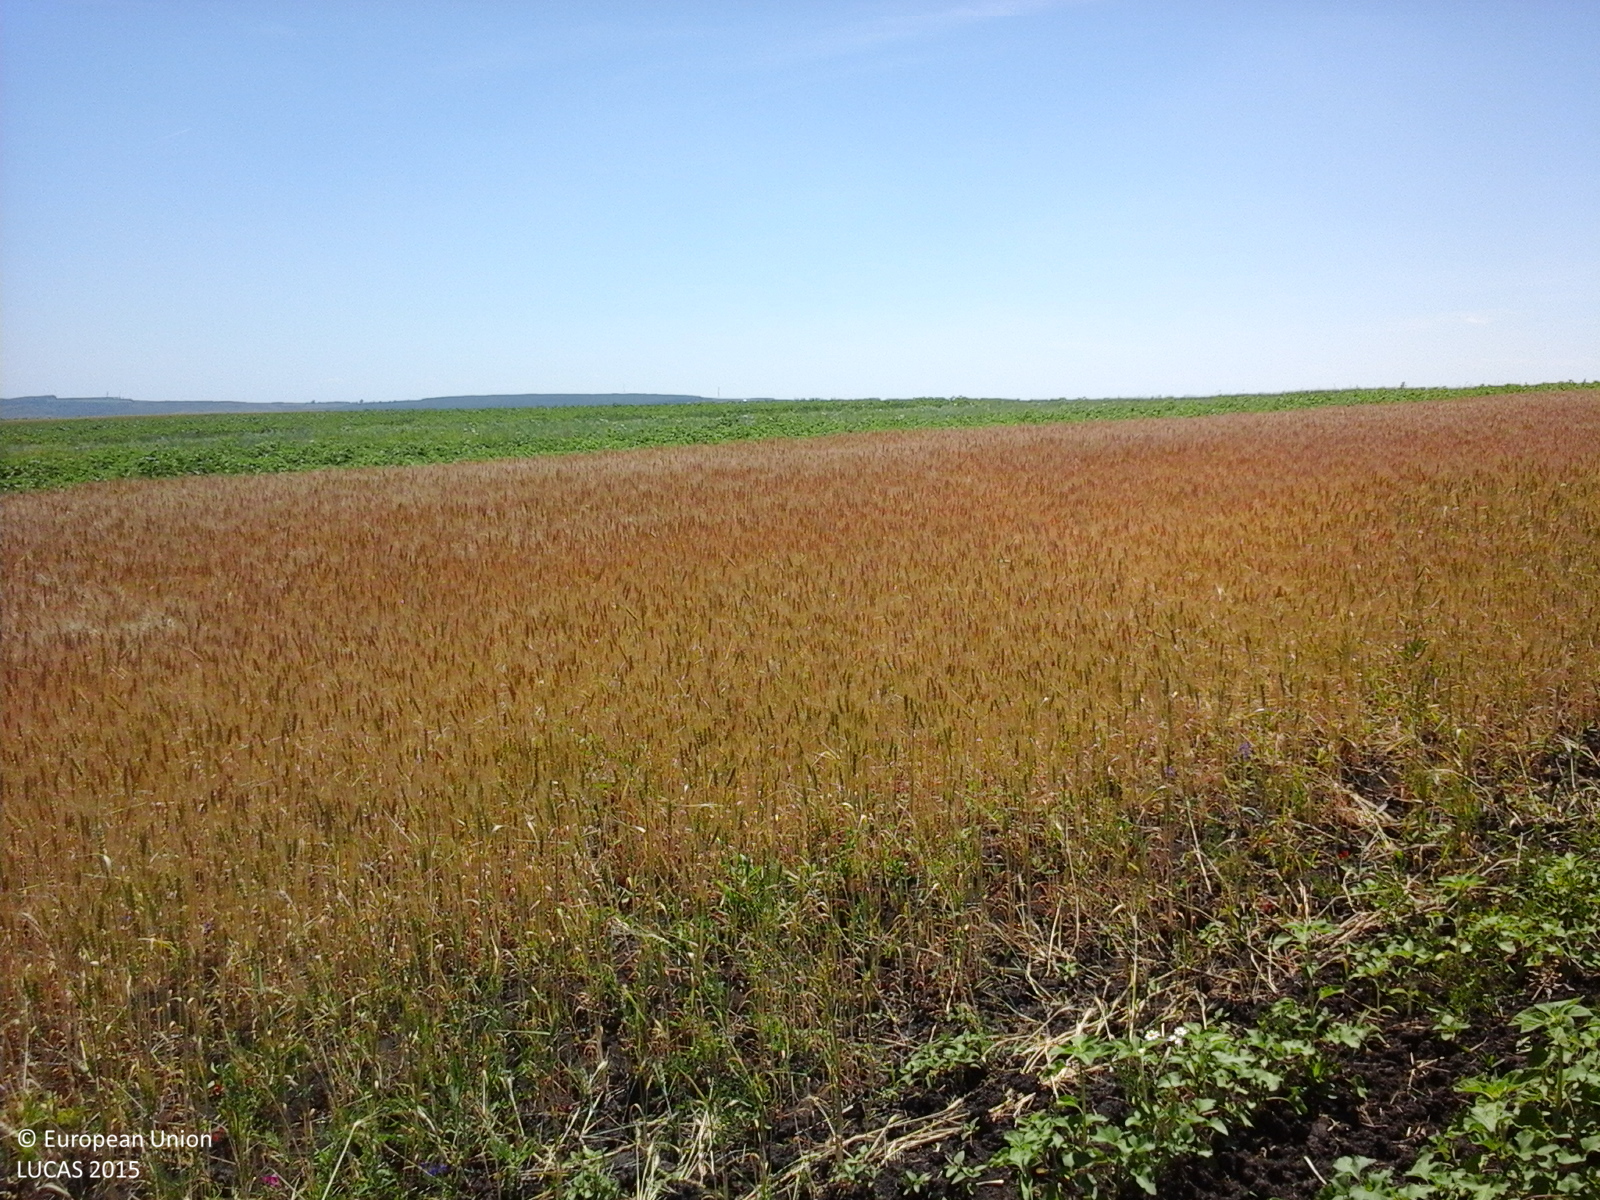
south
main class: Cropland
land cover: Sunflower
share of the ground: > 75 %
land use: Agriculture (excluding fallow land and kitchen gardens)
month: June
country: RO
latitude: 47.2522
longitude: 26.9196
